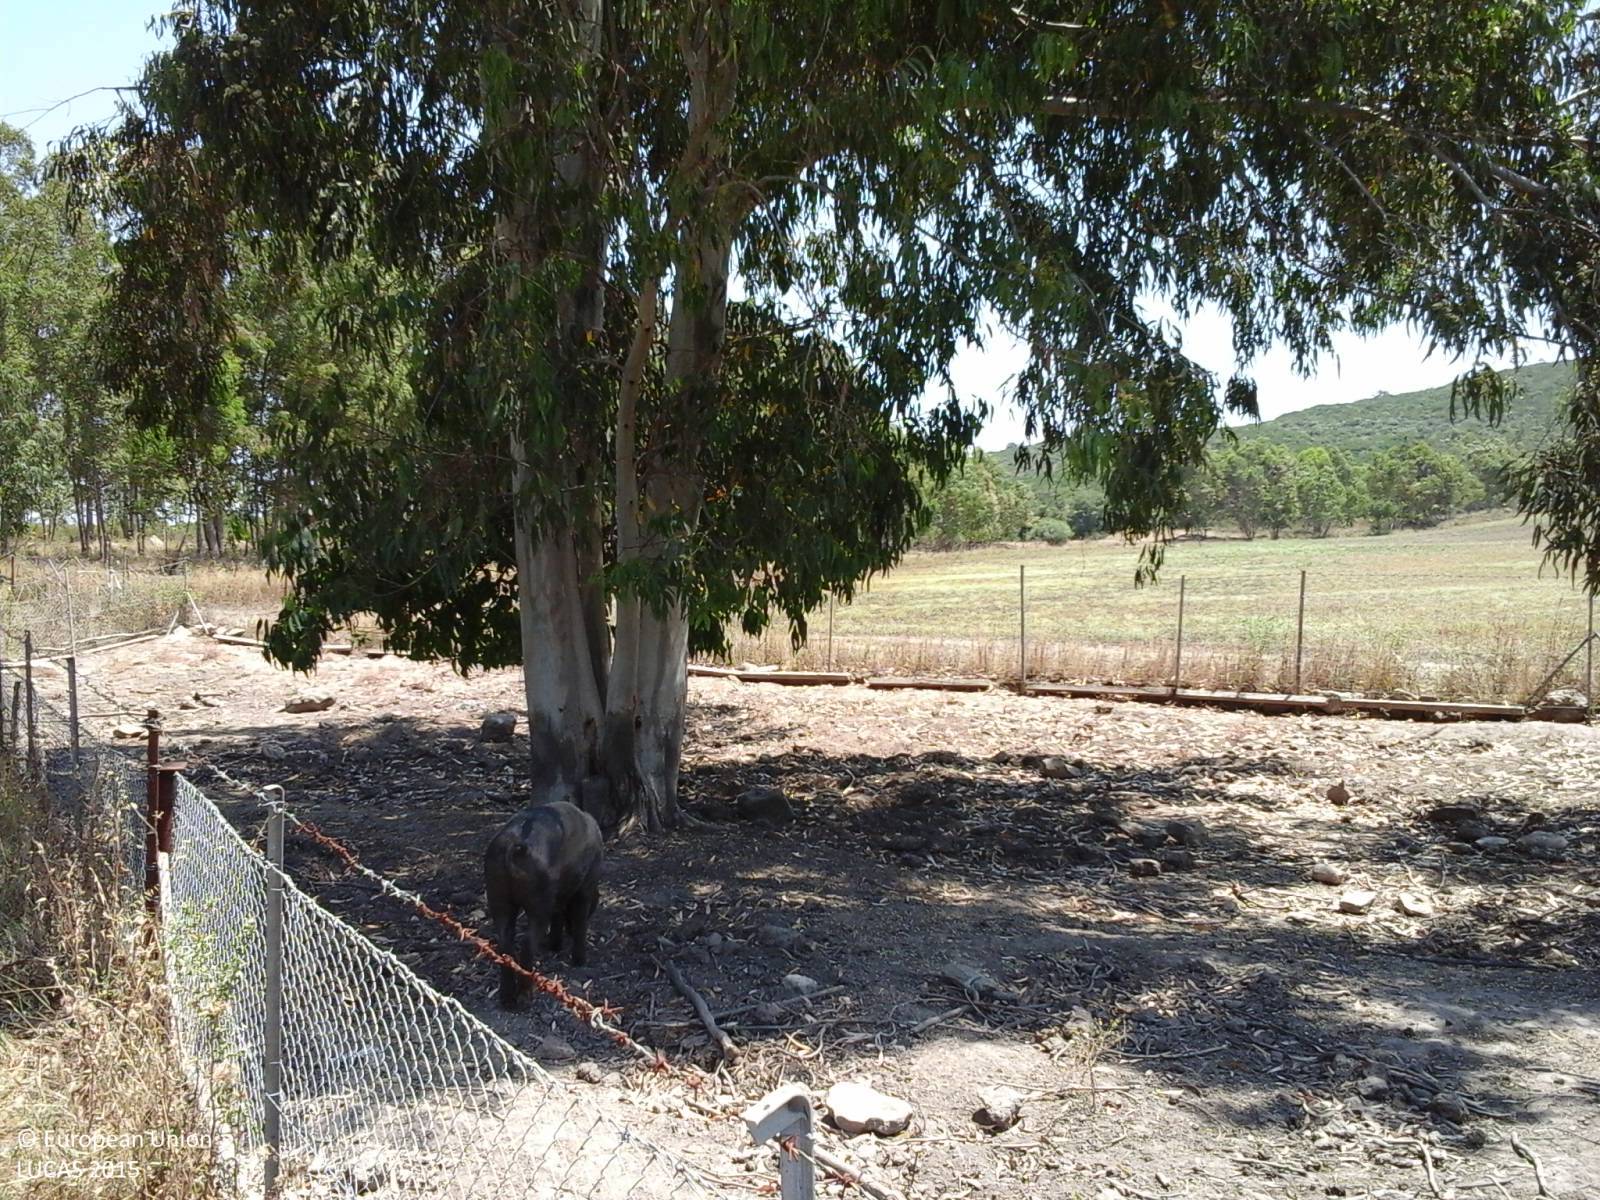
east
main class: Woodland
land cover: Broadleaved woodland
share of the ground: > 75 %
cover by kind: broadleaved forest trees 50 %, unconsolidated bare surface 40 %, herbaceous plants 10 %
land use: Agriculture (excluding fallow land and kitchen gardens)
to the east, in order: Fences; Broadleaved woodland; Fences; Tracks; Grassland without tree/shrub cover; Fences; Tracks; Fences; Broadleaved woodland; Other structural elements; Shrubland without tree cover
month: June
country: IT
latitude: 39.8619
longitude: 8.8259
